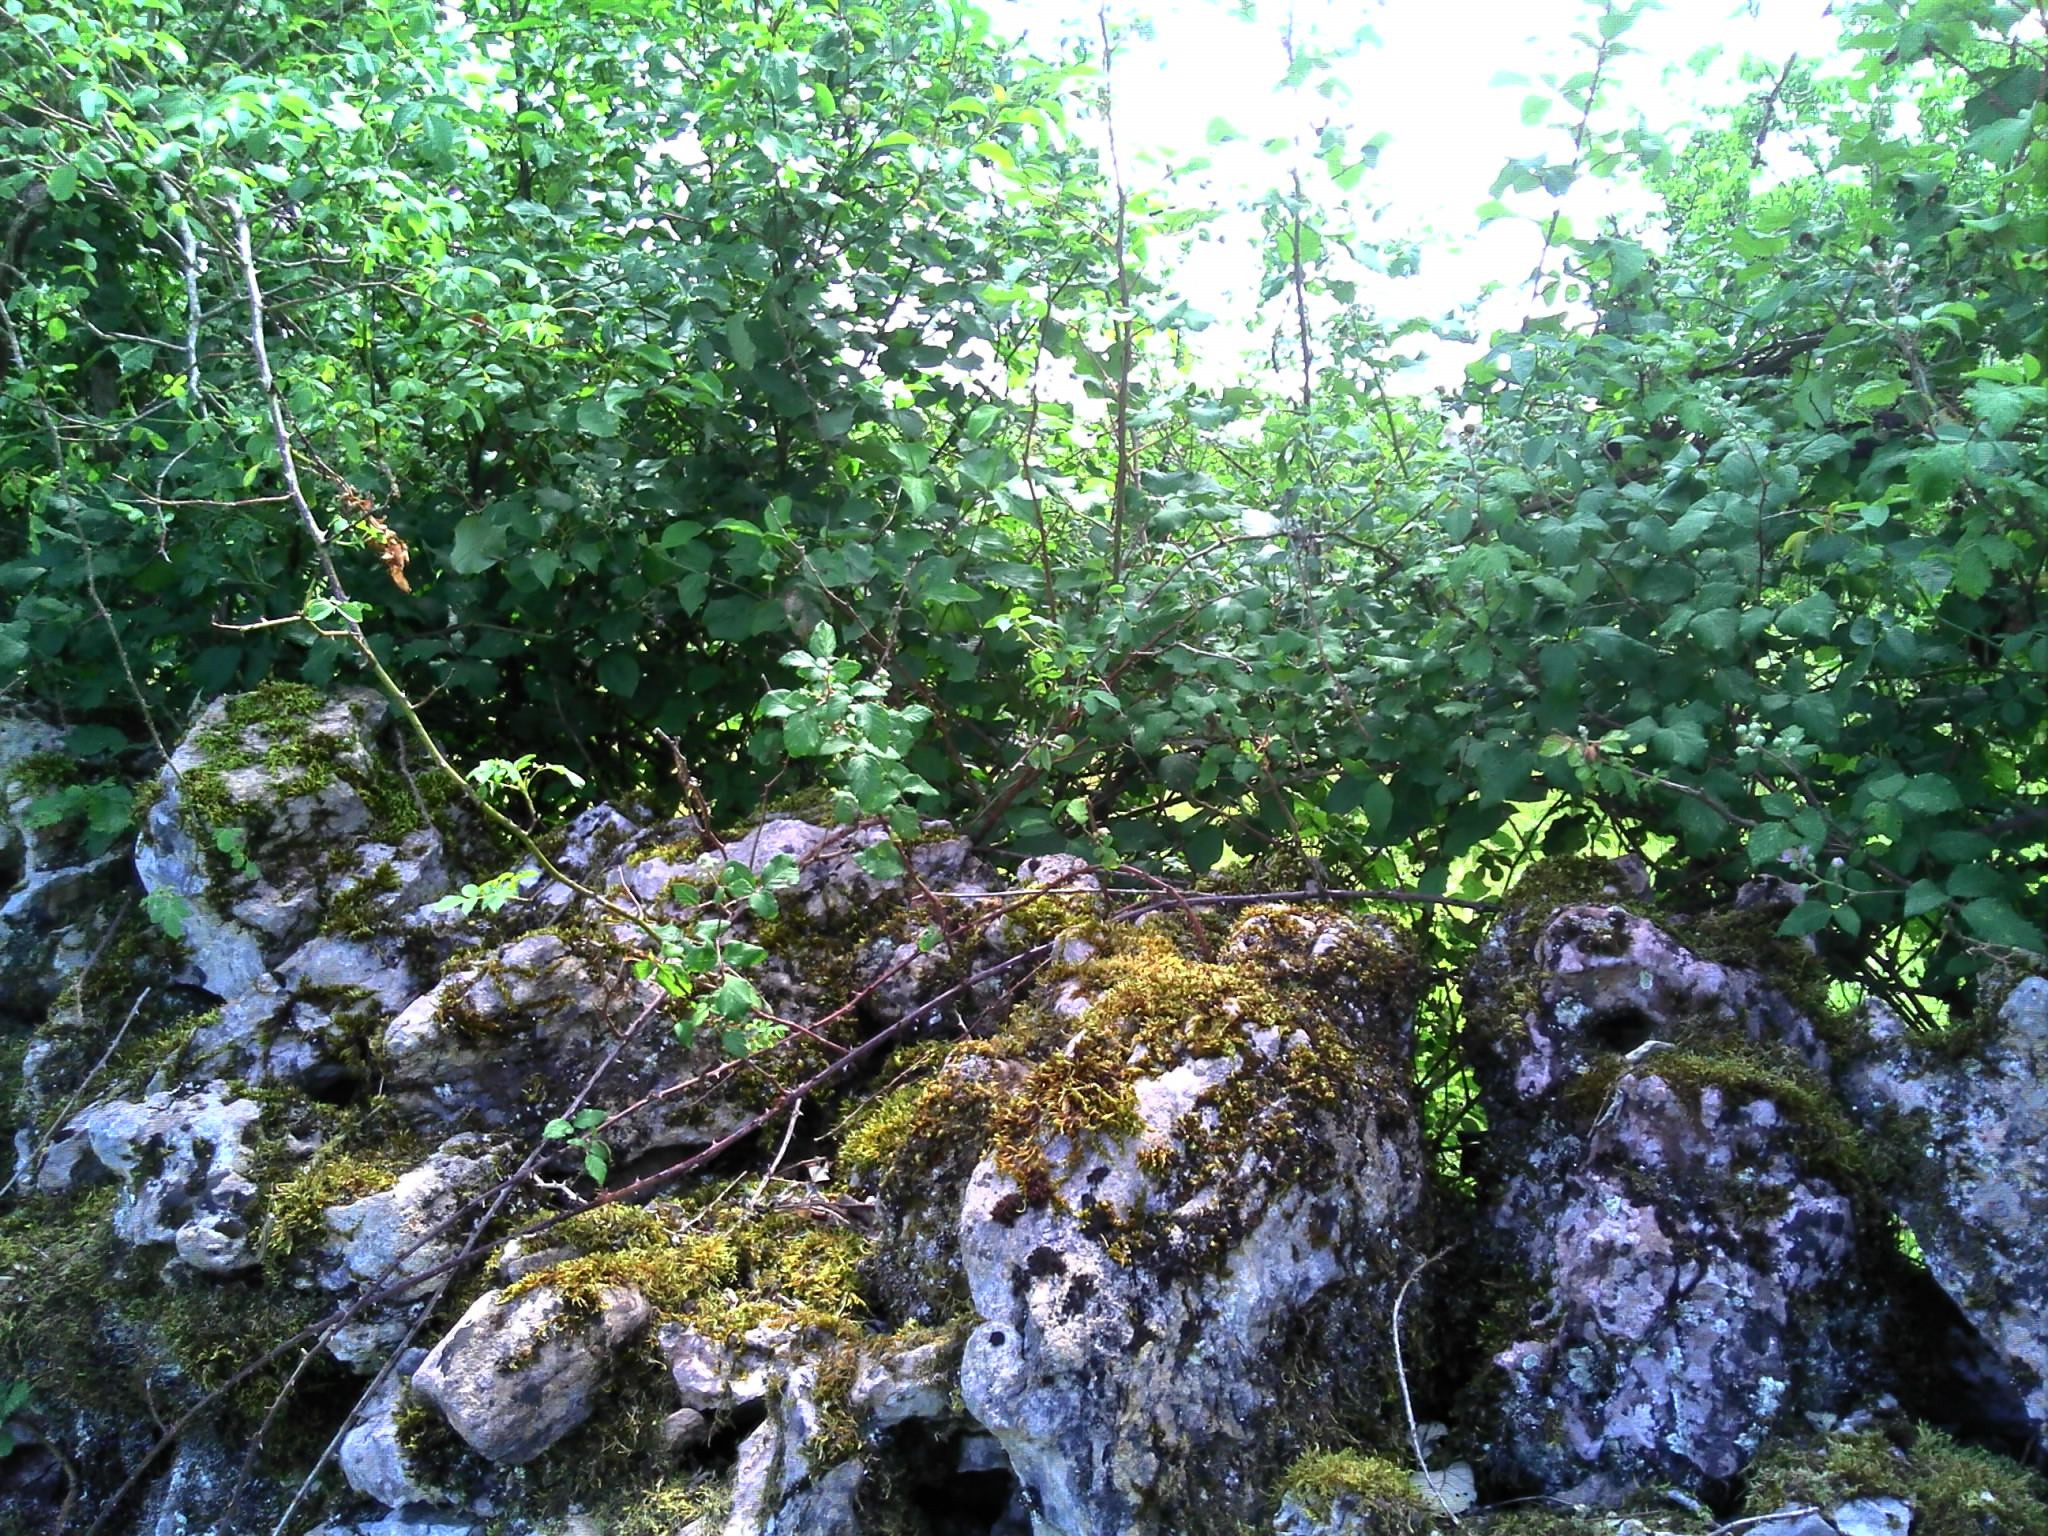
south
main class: Grassland
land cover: Grassland without tree/shrub cover
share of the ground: > 75 %
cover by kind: herbaceous plants 100 %
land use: Agriculture (excluding fallow land and kitchen gardens)
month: June
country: FR
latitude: 44.8917
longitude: 1.7547
